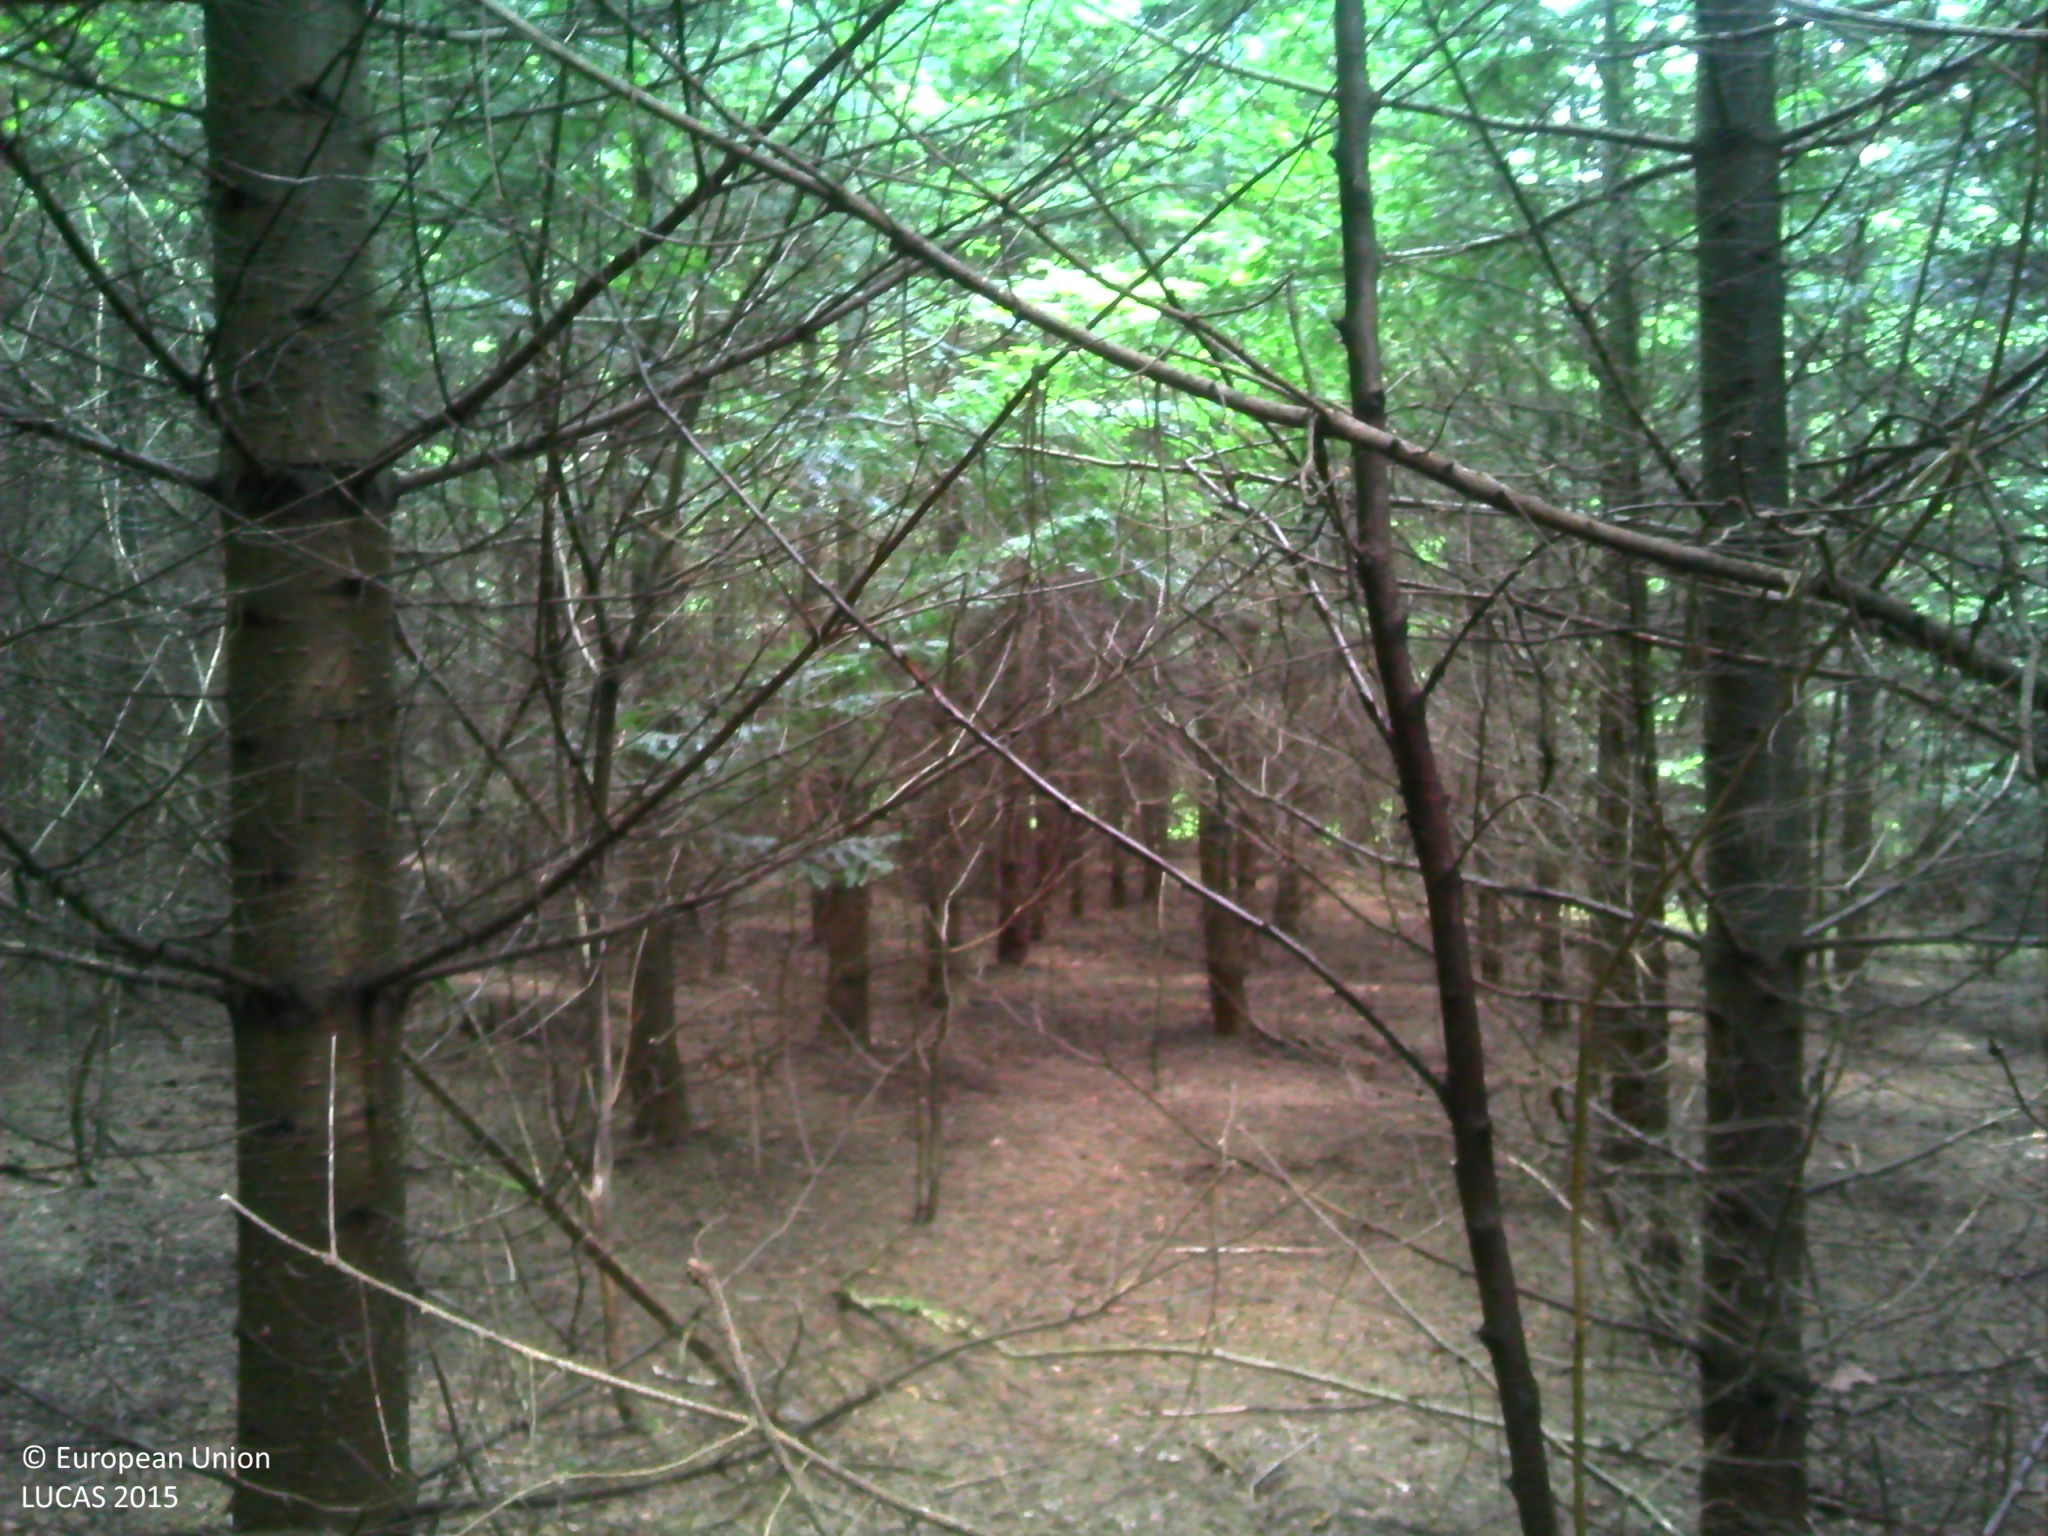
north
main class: Woodland
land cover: Other coniferous woodland
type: hemiboreal forest and nemoral coniferous forest and mixed broadleaved-coniferous forest
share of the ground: > 75 %
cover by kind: coniferous forest trees 95 %, broadleaved forest trees 5 %
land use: Forestry
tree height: > 5 m
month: June
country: BE
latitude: 49.9804
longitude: 4.9070
